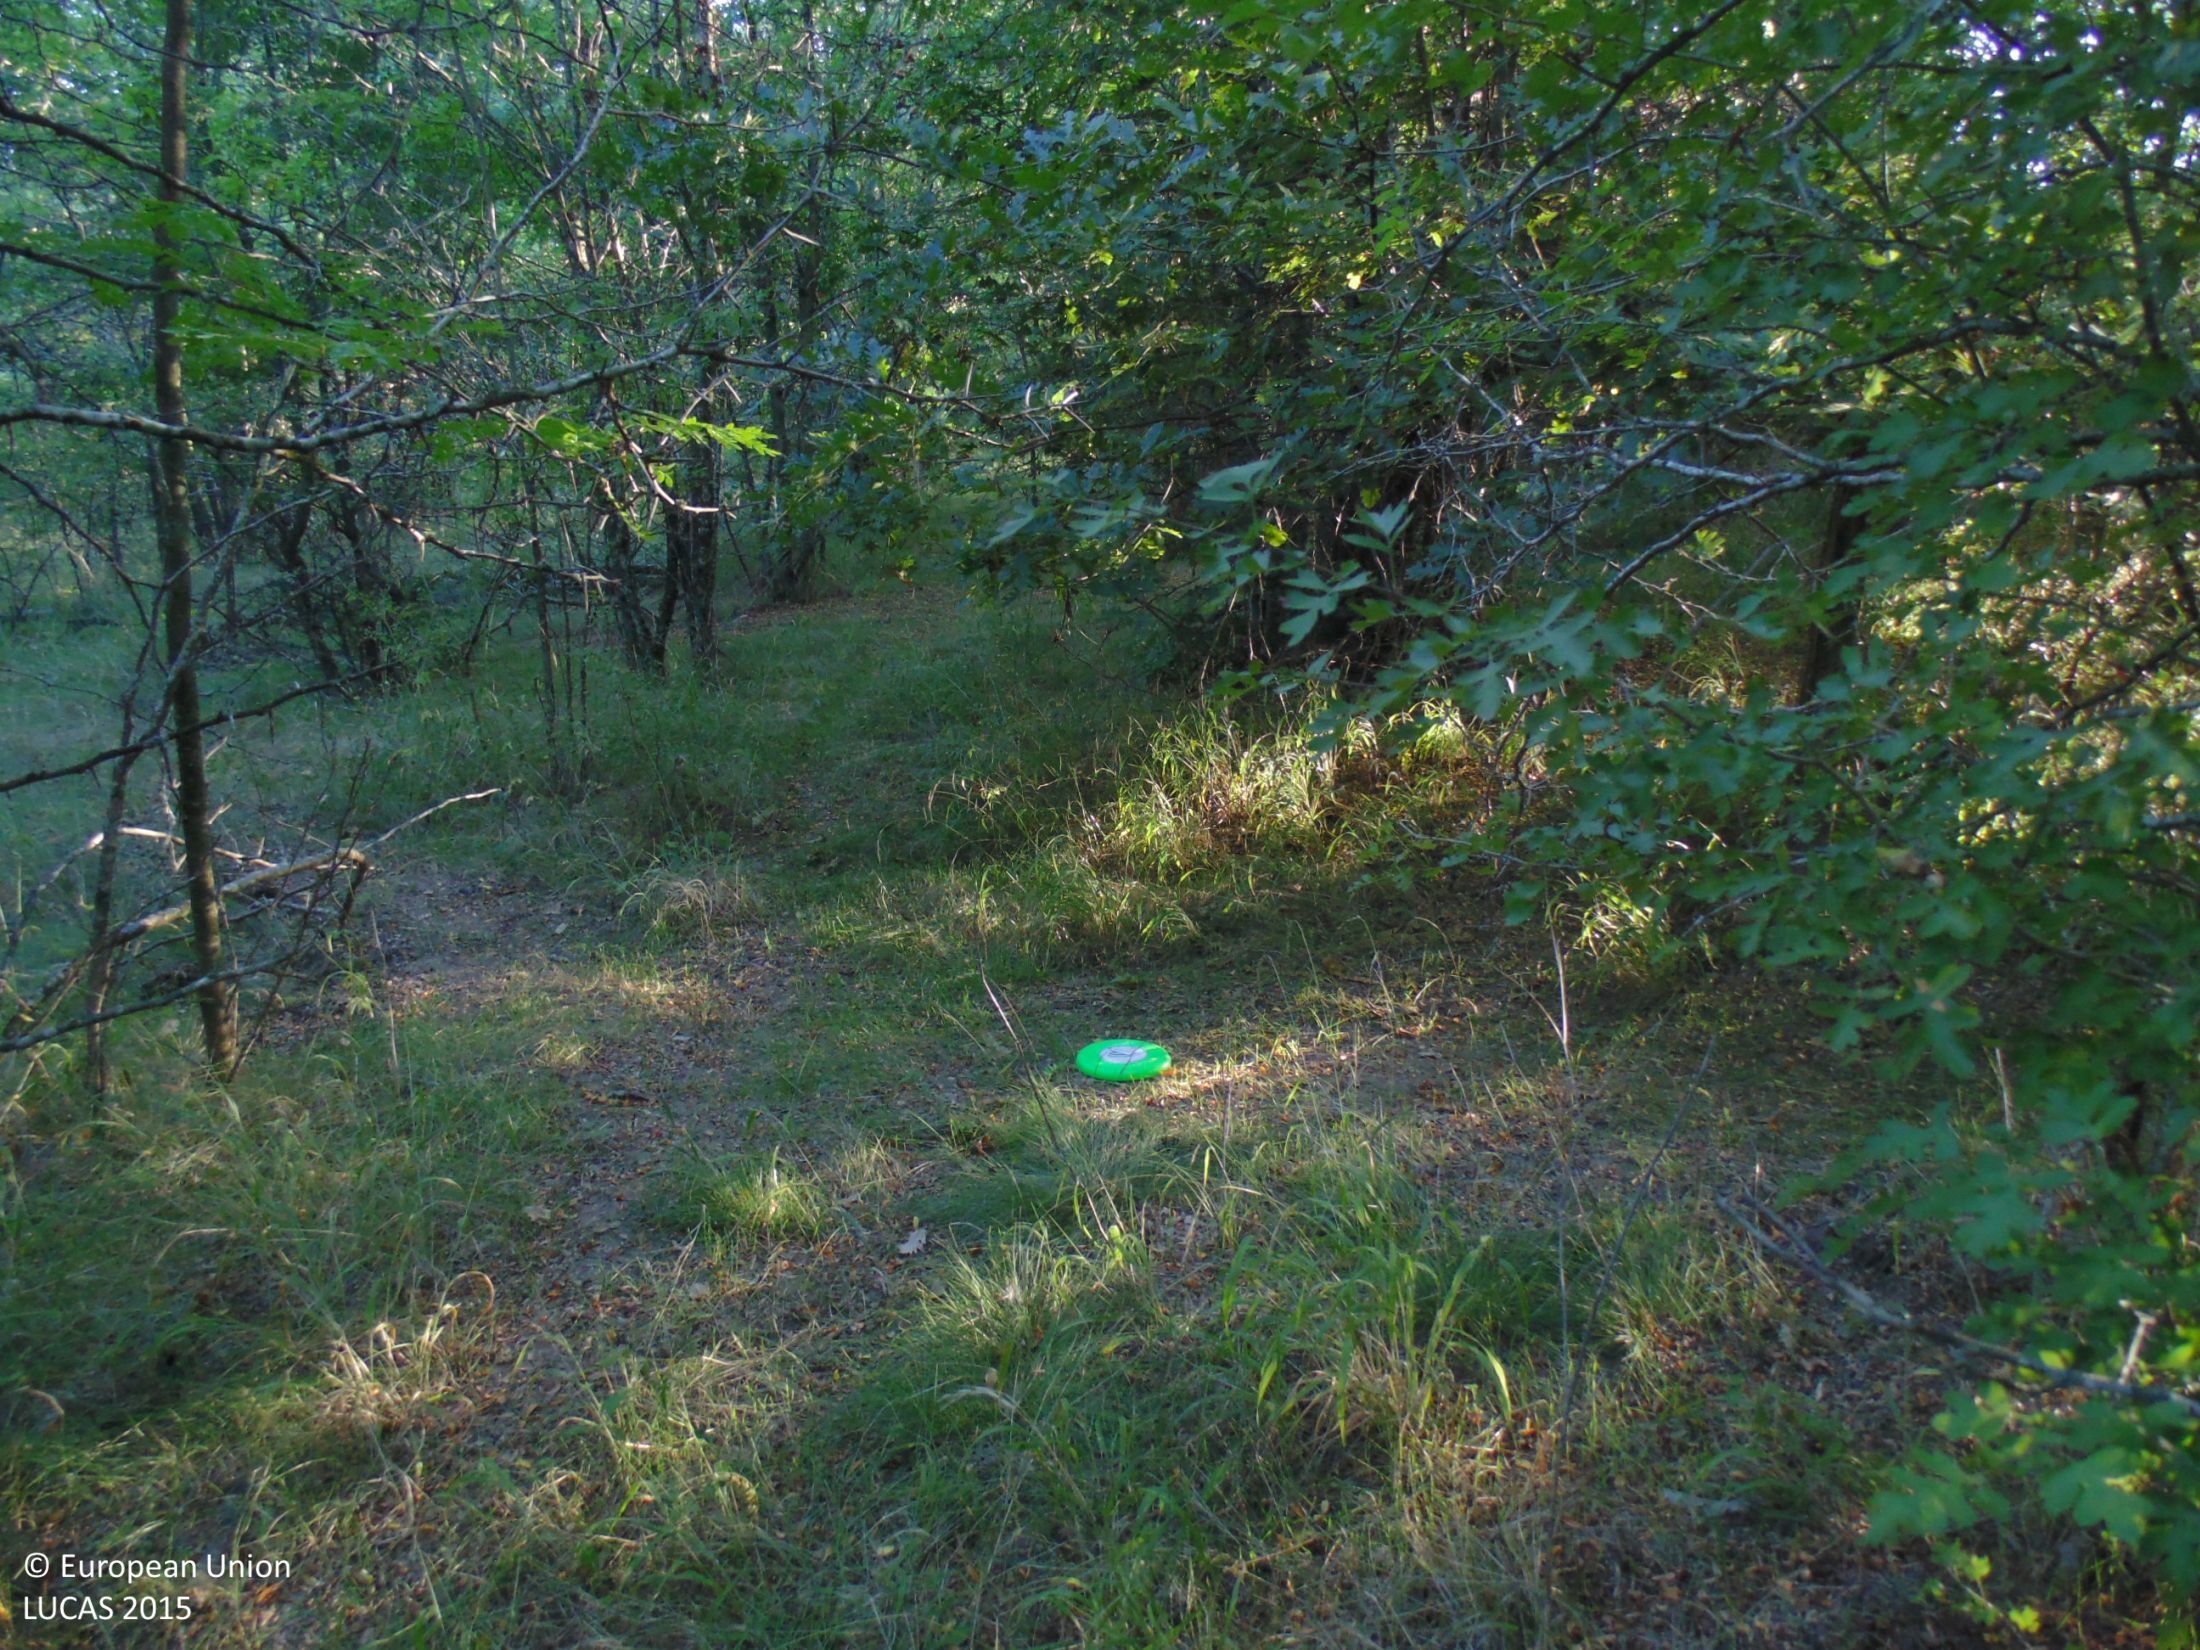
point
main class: Woodland
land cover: Broadleaved woodland
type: mesophytic deciduous forest
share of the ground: > 75 %
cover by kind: broadleaved forest trees 95 %, unconsolidated bare surface 5 %
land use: Forestry
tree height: > 5 m
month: September
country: BG
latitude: 43.7921
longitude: 27.2657
